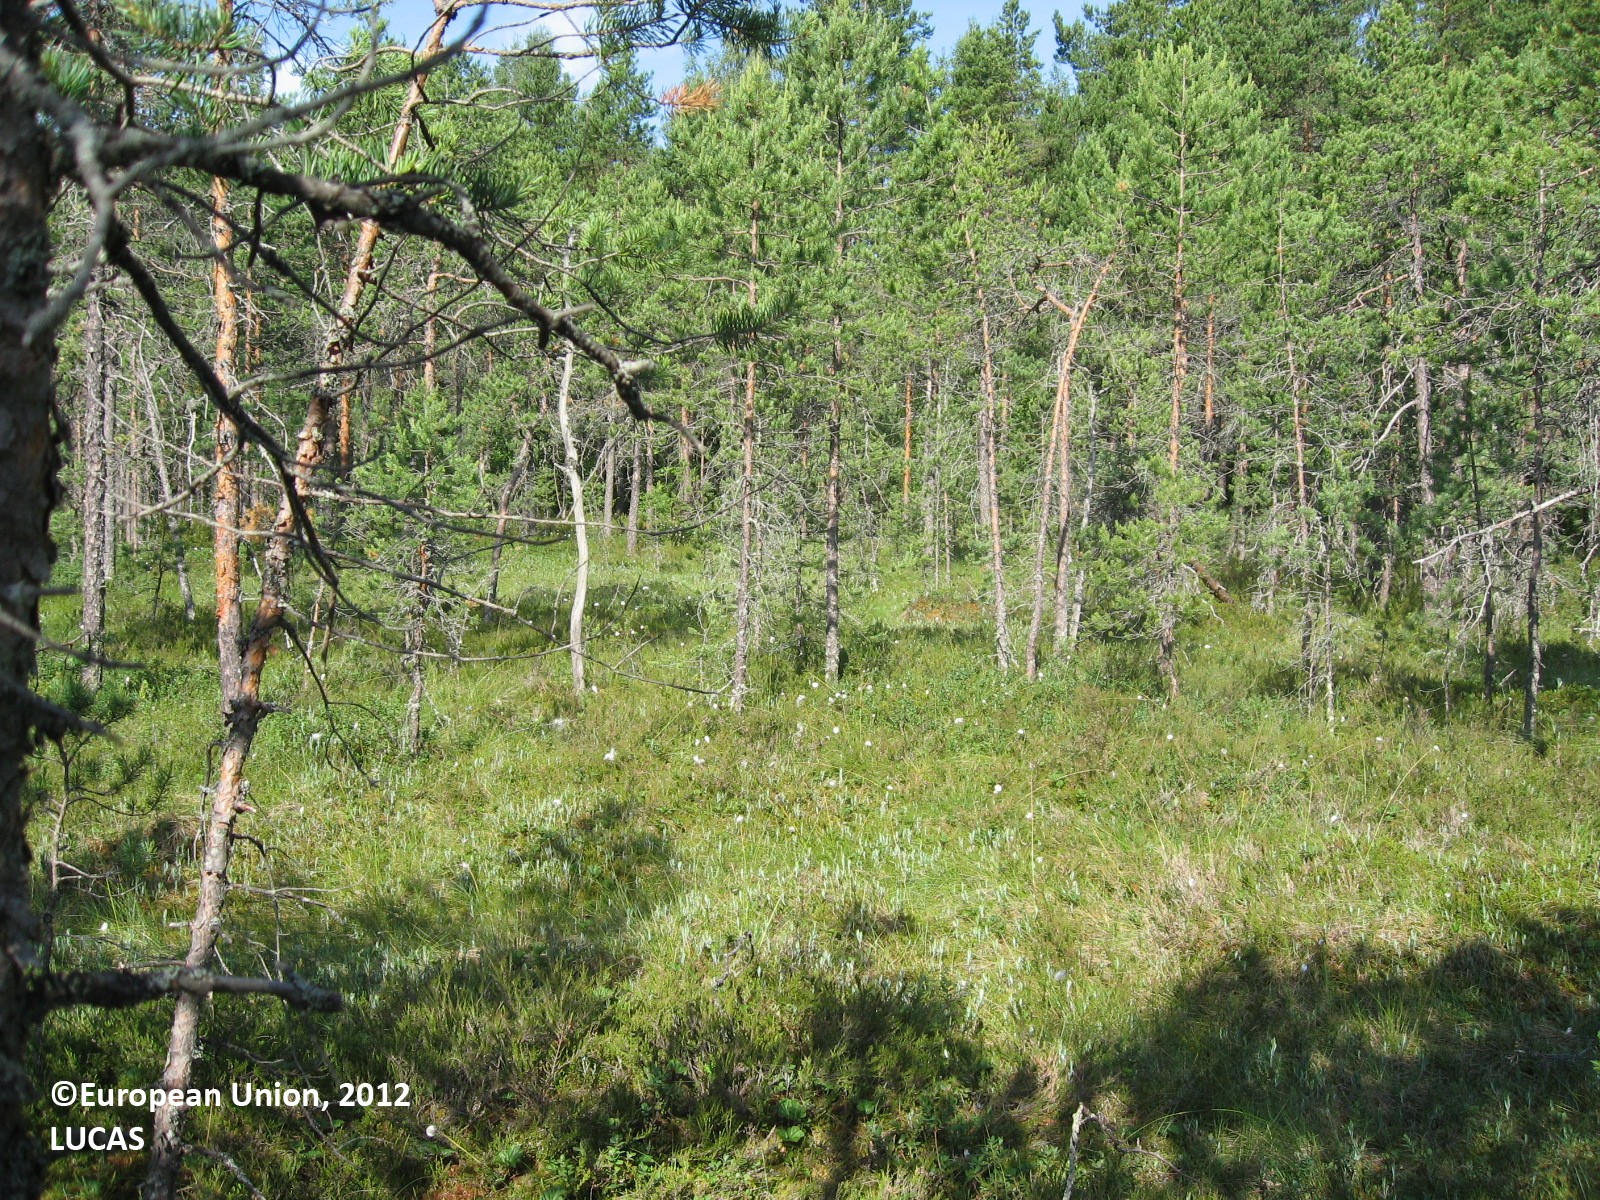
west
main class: Woodland
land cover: Pine dominated coniferous woodland
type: boreal forest
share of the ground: 25 - 50 %
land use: Forestry
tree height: < 5 m
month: July
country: FI
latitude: 60.8661
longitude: 26.4474
